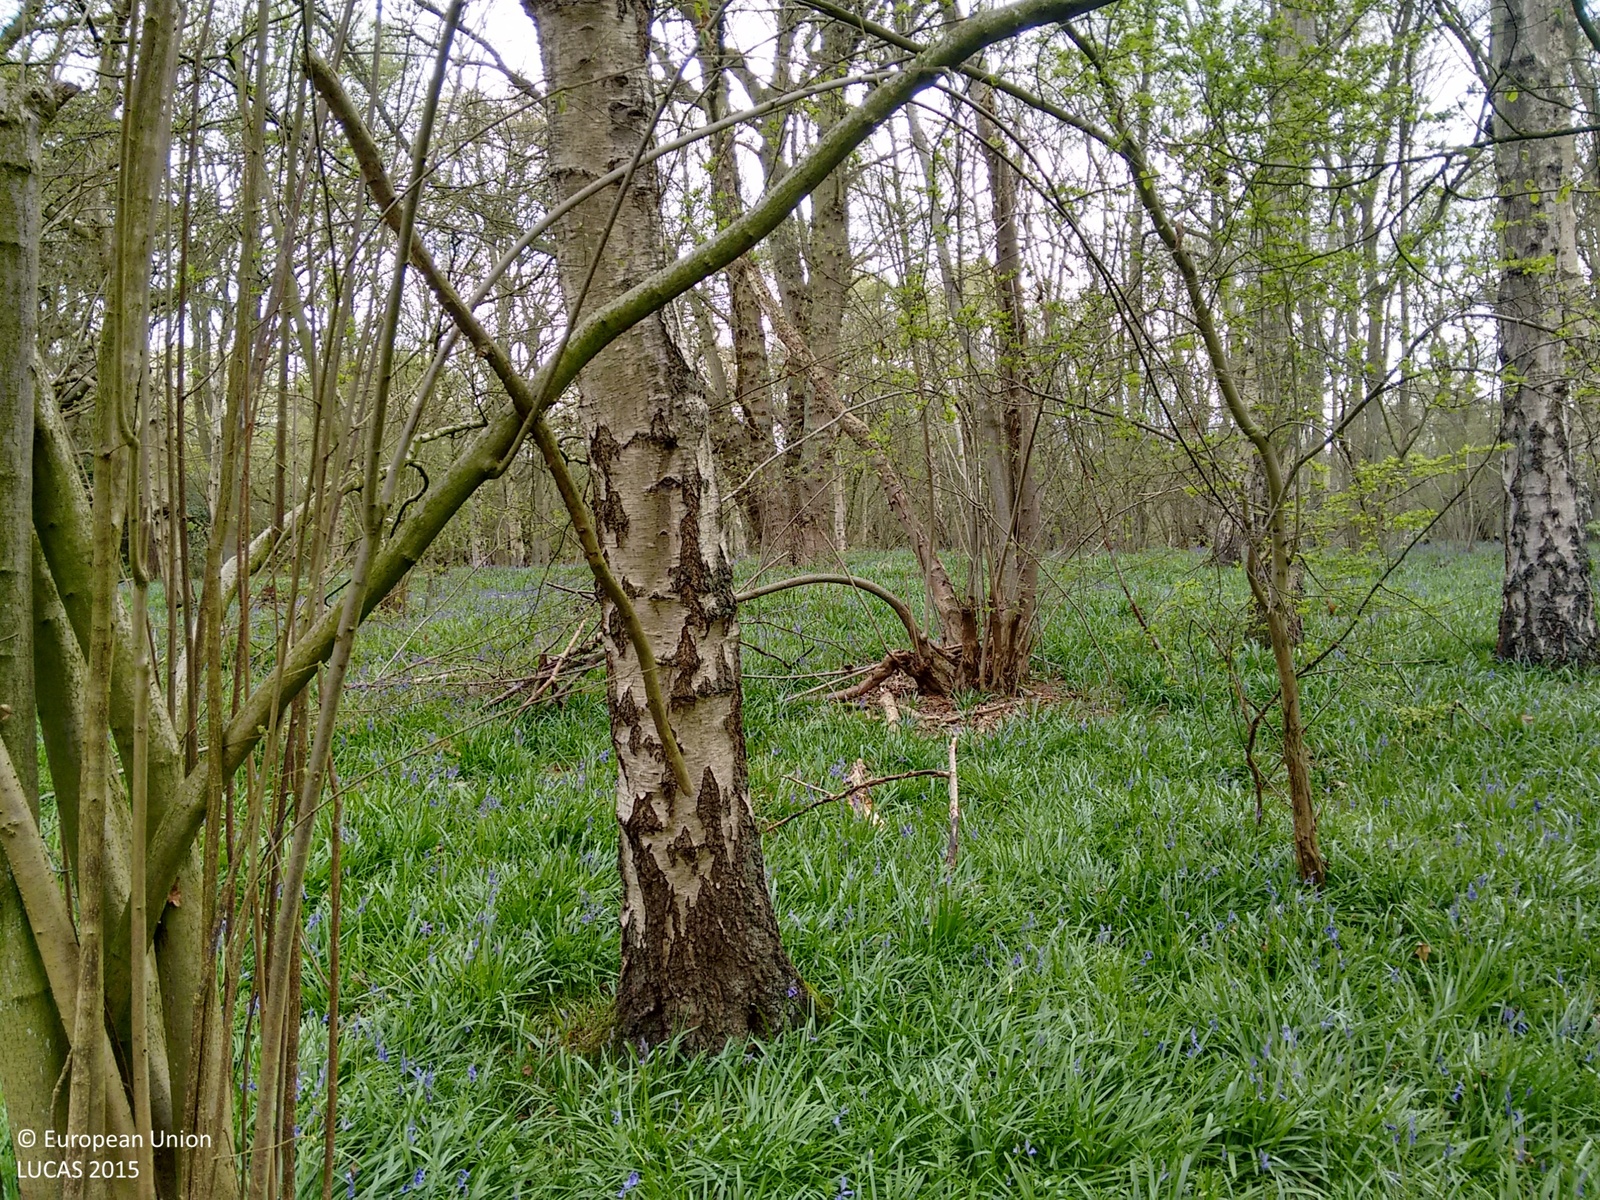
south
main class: Woodland
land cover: Broadleaved woodland
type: mesophytic deciduous forest
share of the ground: > 75 %
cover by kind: broadleaved forest trees 100 %
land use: Forestry
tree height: > 5 m
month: April
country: GB
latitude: 53.2408
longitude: -0.6329
